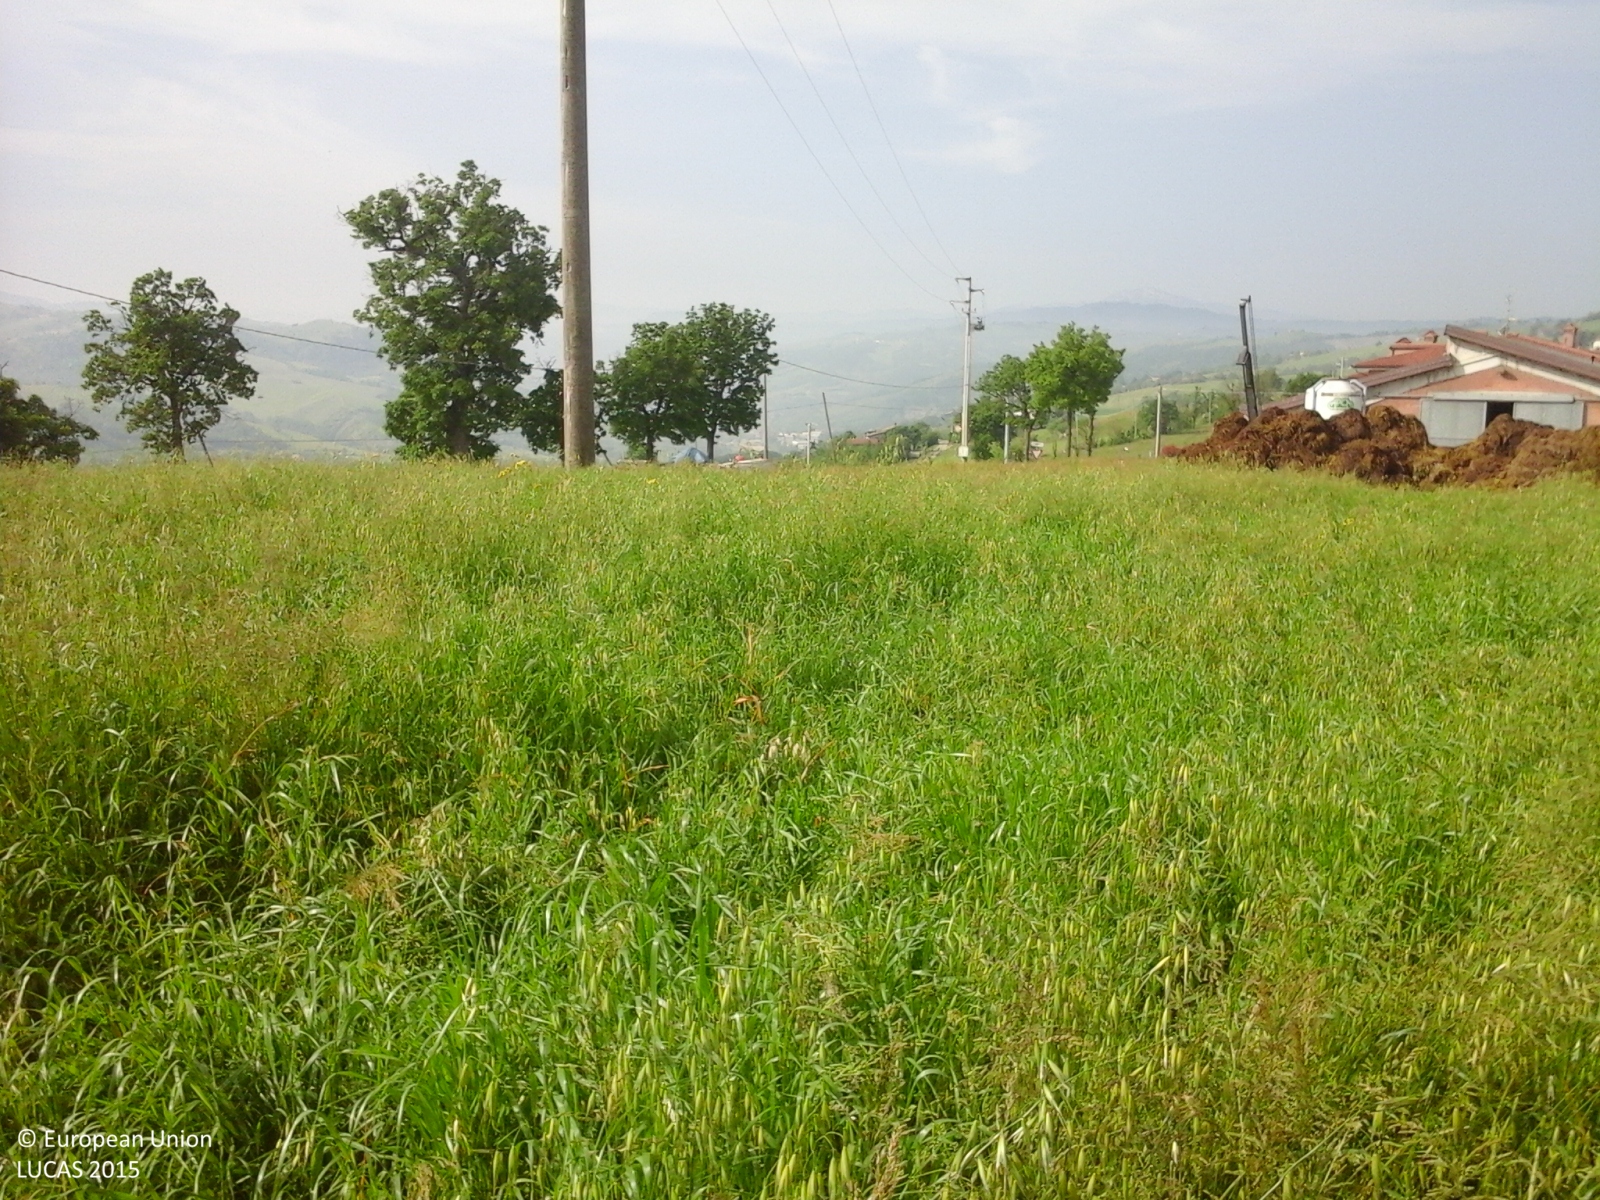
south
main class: Cropland
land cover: Lucerne
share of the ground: > 75 %
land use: Agriculture (excluding fallow land and kitchen gardens)
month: May
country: IT
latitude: 44.4545
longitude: 10.9404
